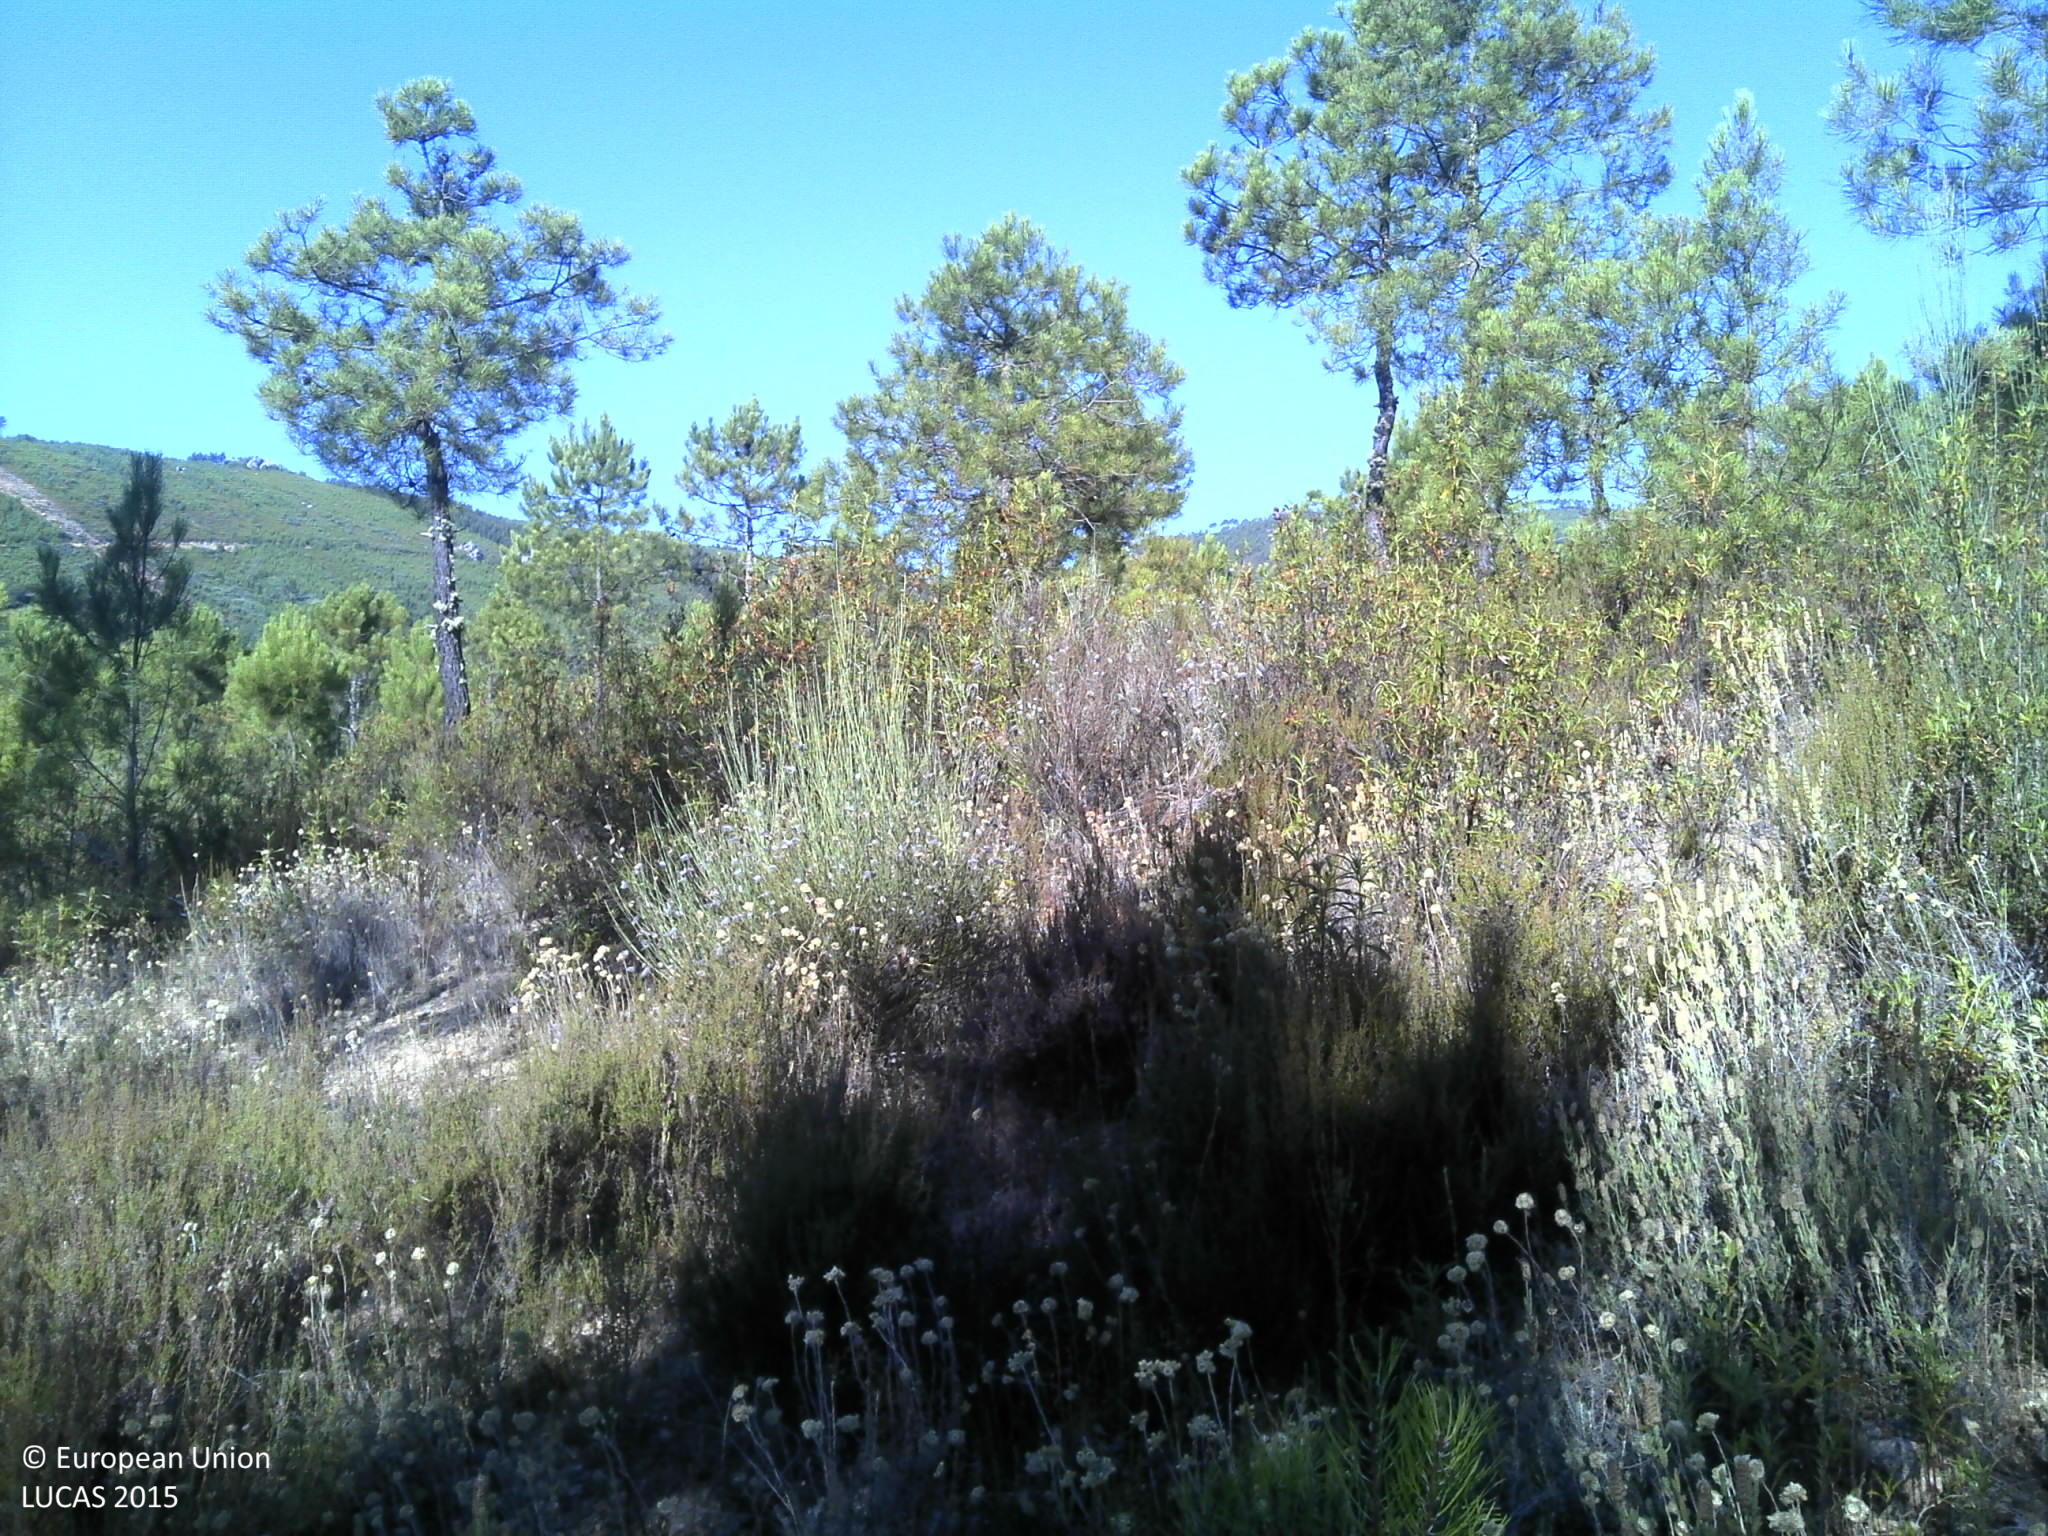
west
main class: Woodland
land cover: Pine dominated coniferous woodland
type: coniferous forest of the mediterranean region
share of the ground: 25 - 50 %
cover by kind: unconsolidated bare surface 40 %, coniferous forest trees 35 %, shrubs 25 %
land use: Forestry
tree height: > 5 m
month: July
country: PT
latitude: 39.9806
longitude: -7.6592
